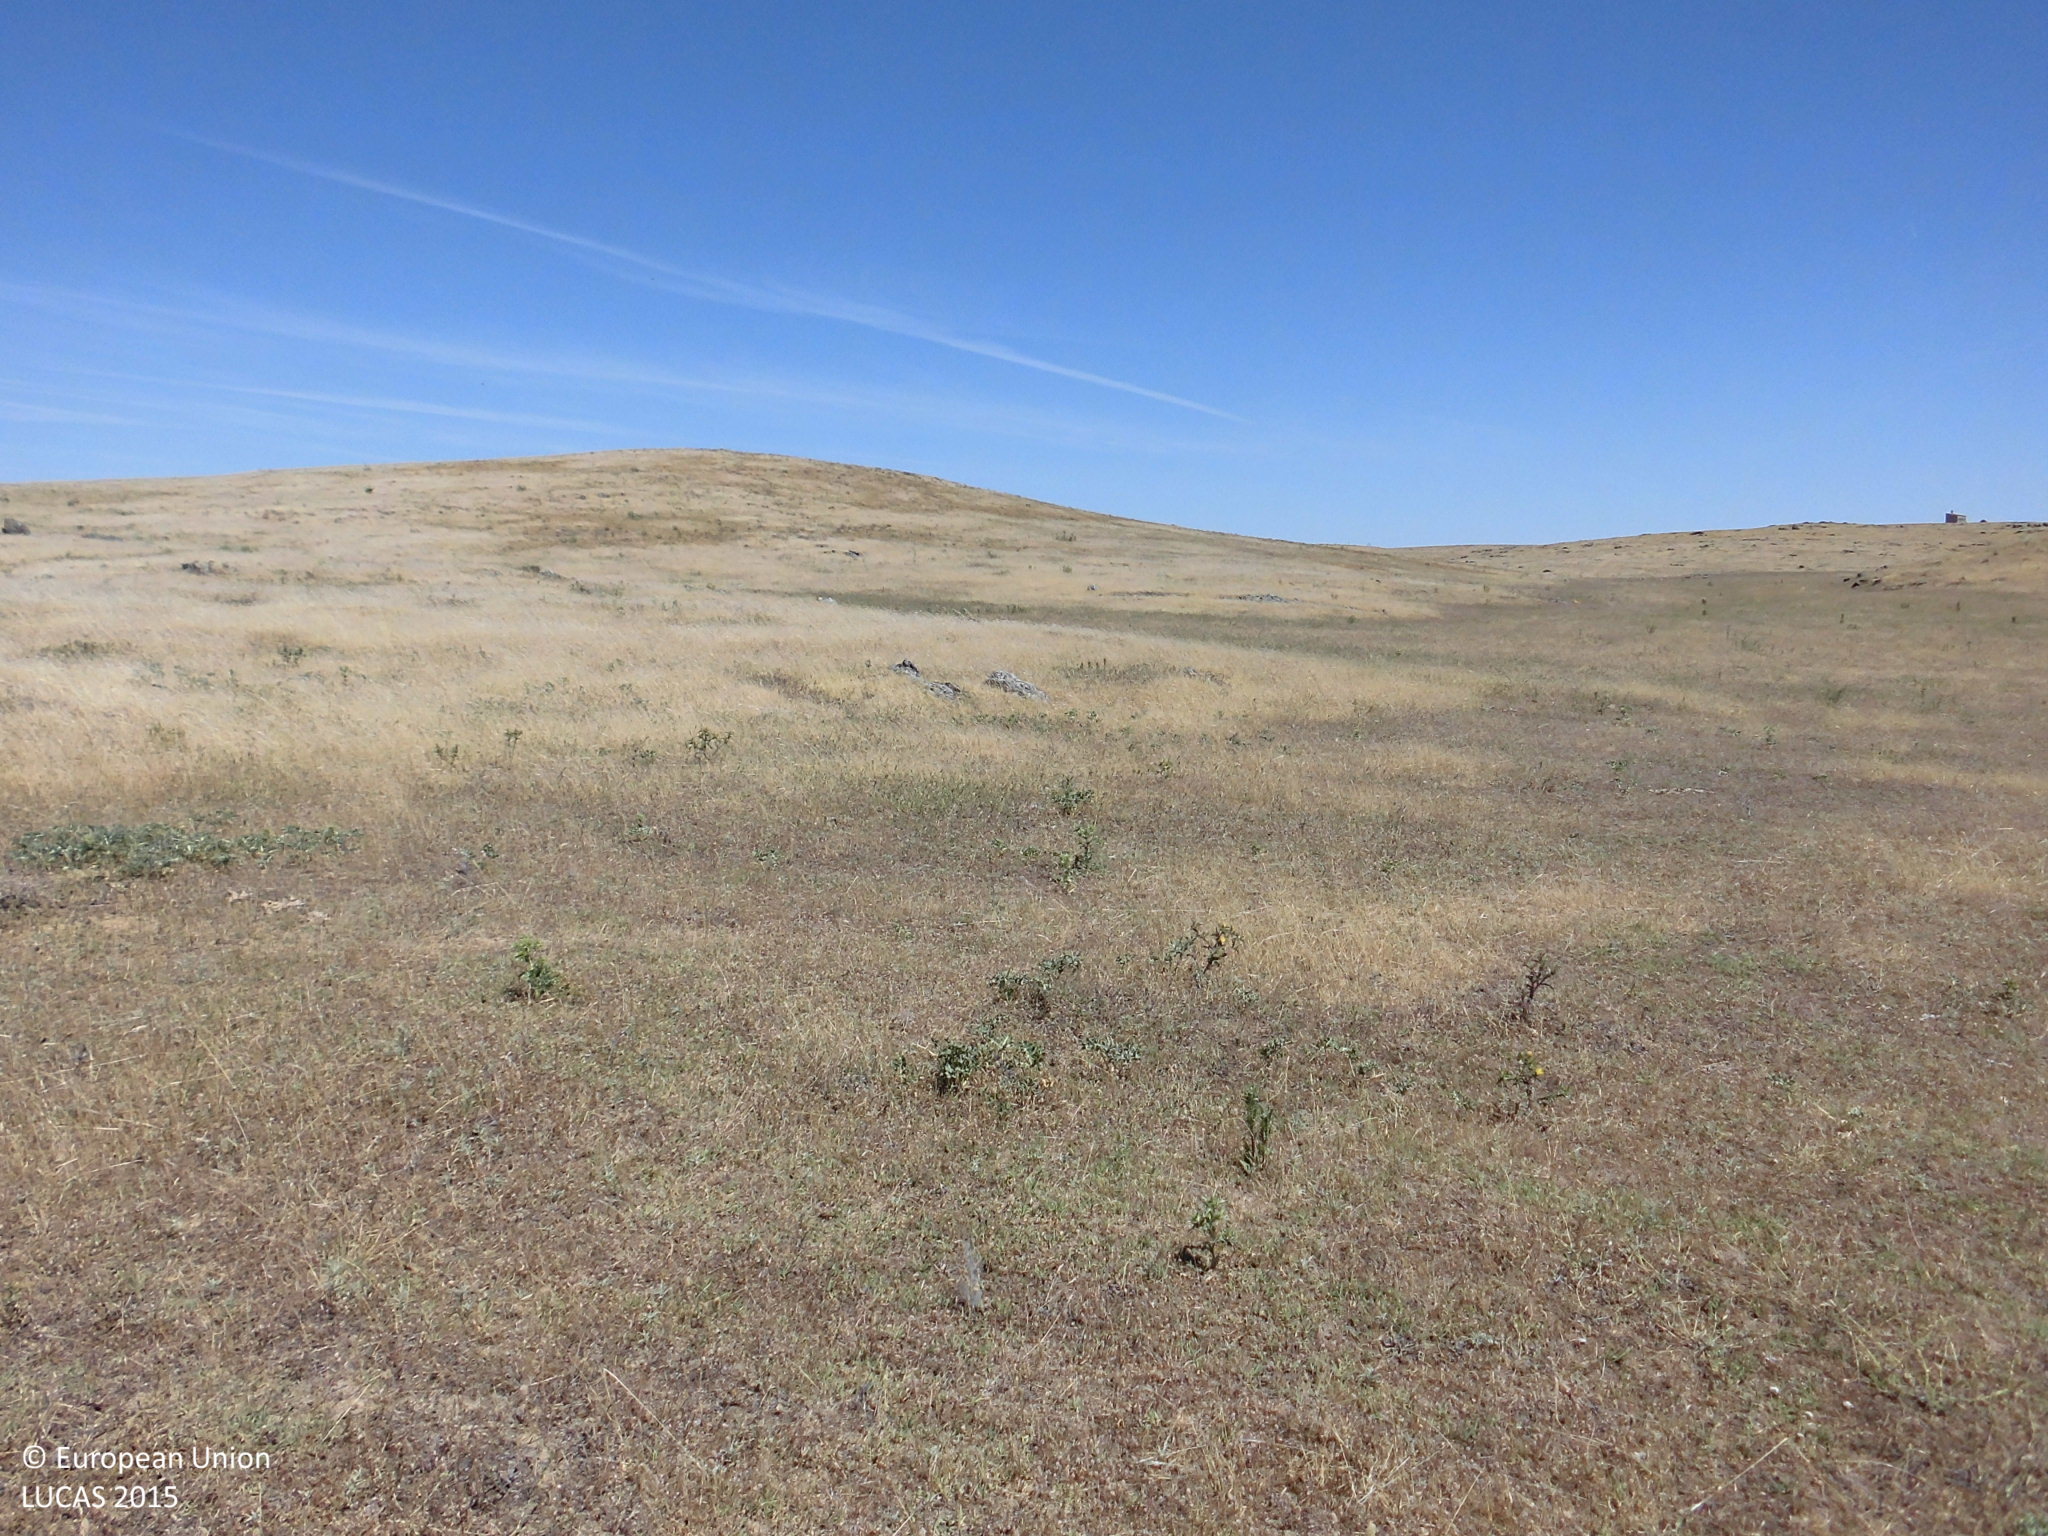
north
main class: Grassland
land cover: Grassland without tree/shrub cover
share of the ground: > 75 %
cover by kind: herbaceous plants 100 %
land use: Agriculture (excluding fallow land and kitchen gardens)
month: May
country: ES
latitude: 39.5716
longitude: -6.8543
